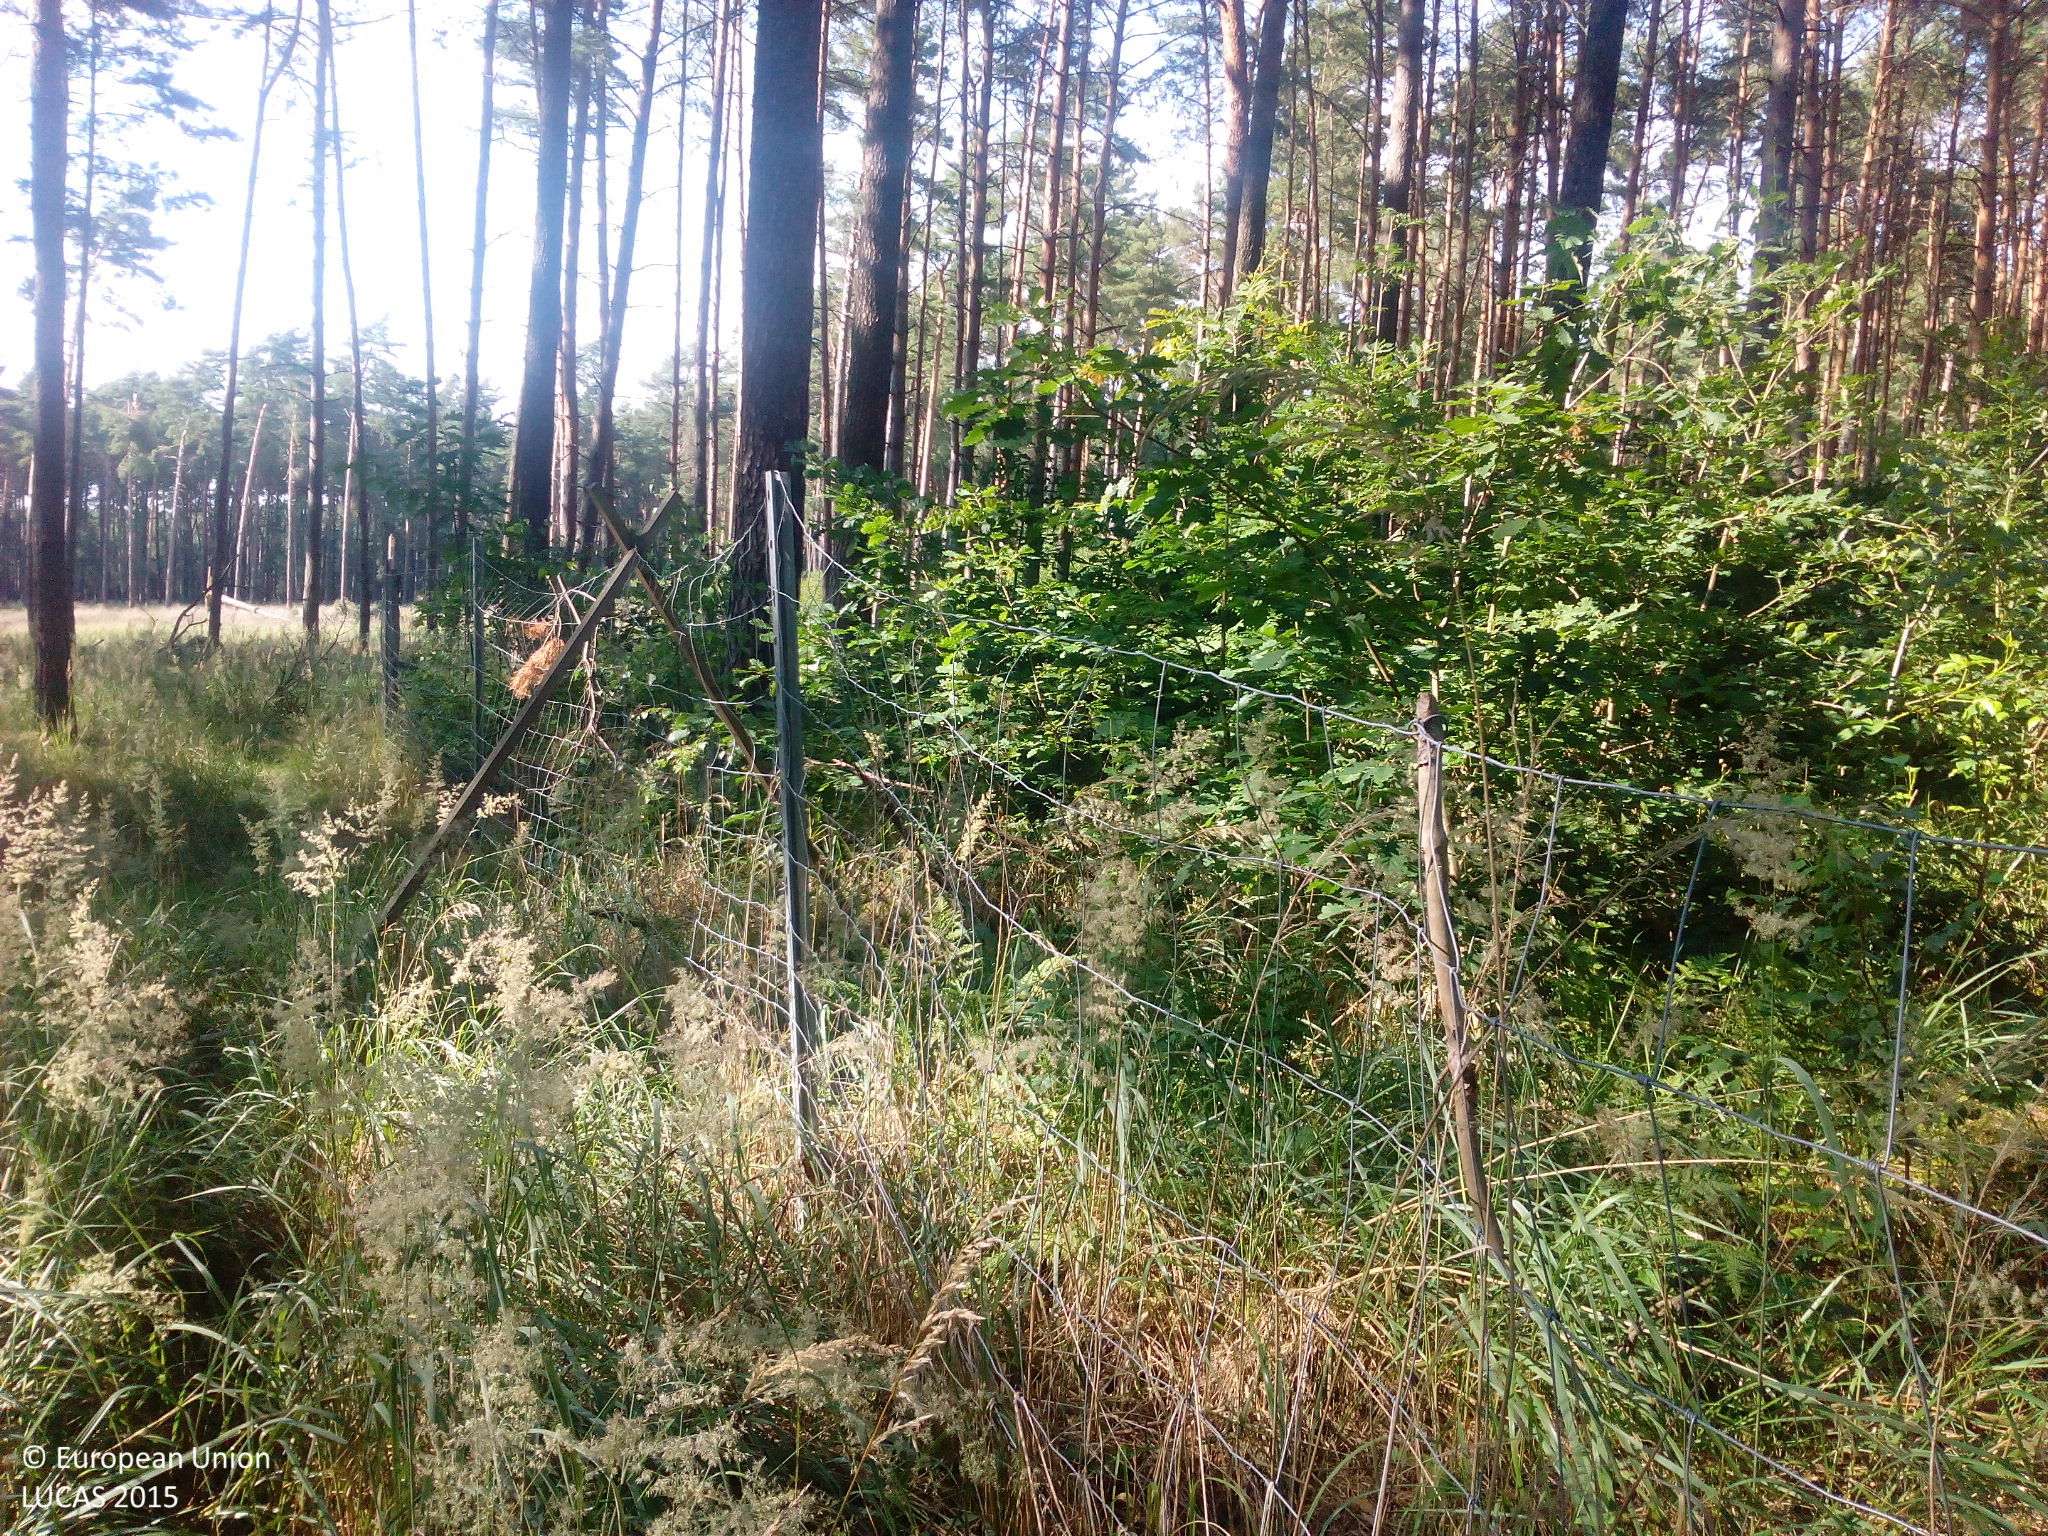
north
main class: Woodland
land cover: Pine dominated mixed woodland
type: hemiboreal forest and nemoral coniferous forest and mixed broadleaved-coniferous forest
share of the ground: > 75 %
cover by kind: coniferous forest trees 70 %, broadleaved forest trees 30 %
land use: Forestry
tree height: > 5 m
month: July
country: DE
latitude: 51.9725
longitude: 12.5472
